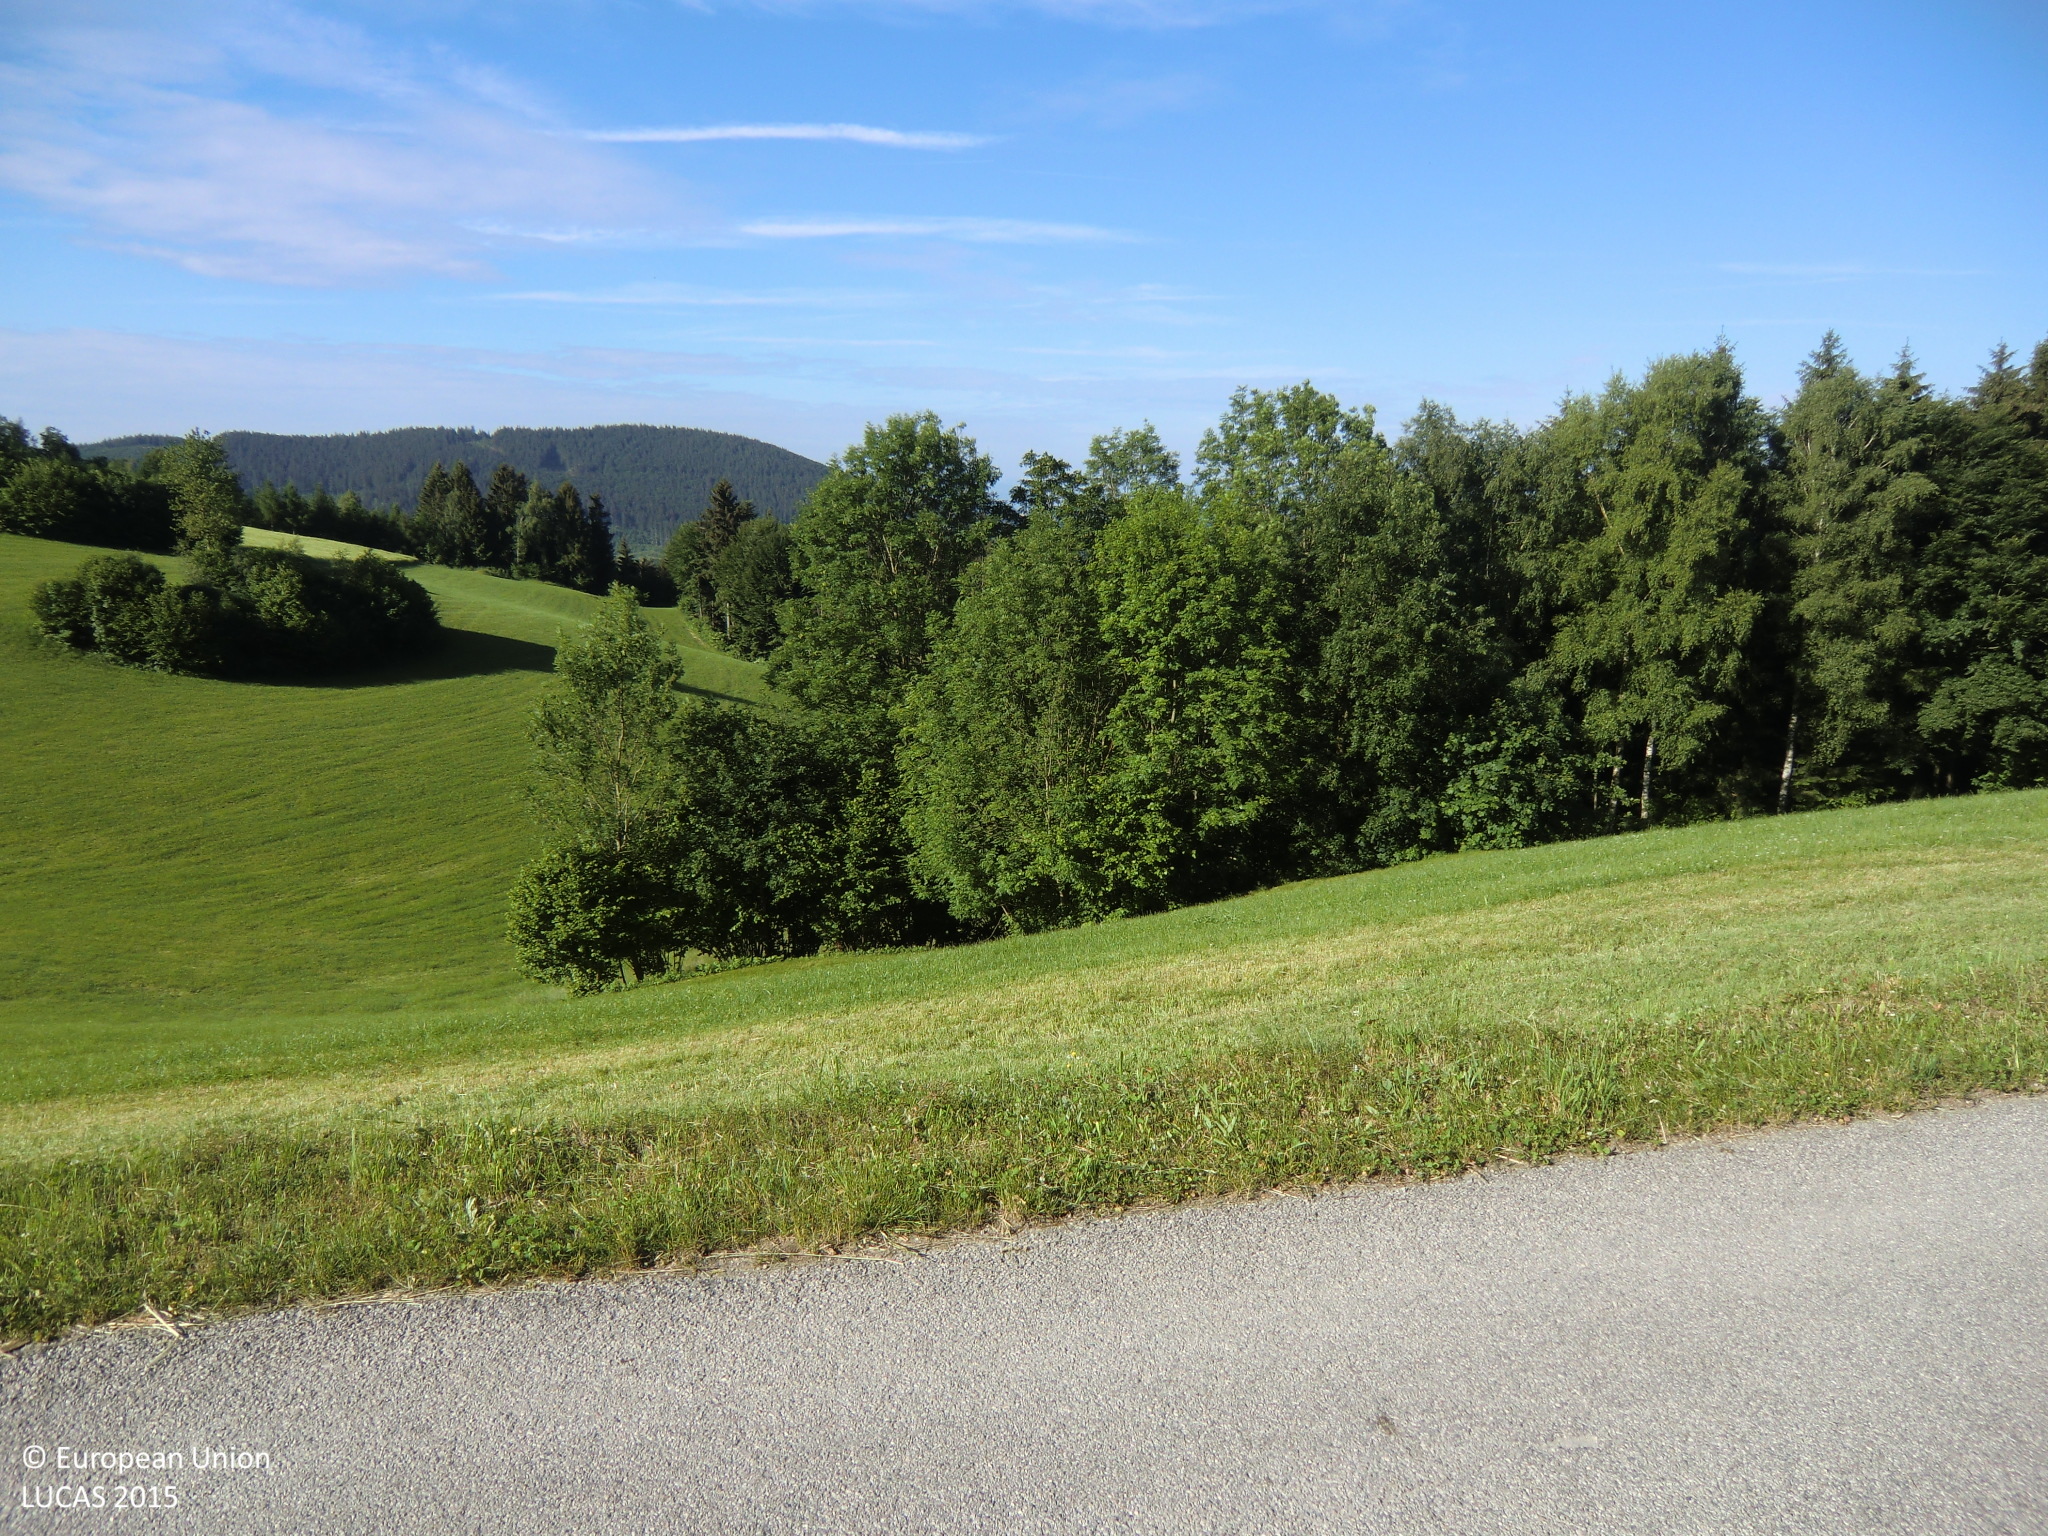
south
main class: Grassland
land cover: Grassland without tree/shrub cover
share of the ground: > 75 %
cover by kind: herbaceous plants 100 %
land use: Agriculture (excluding fallow land and kitchen gardens)
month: June
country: AT
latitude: 48.2736
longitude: 14.9731
